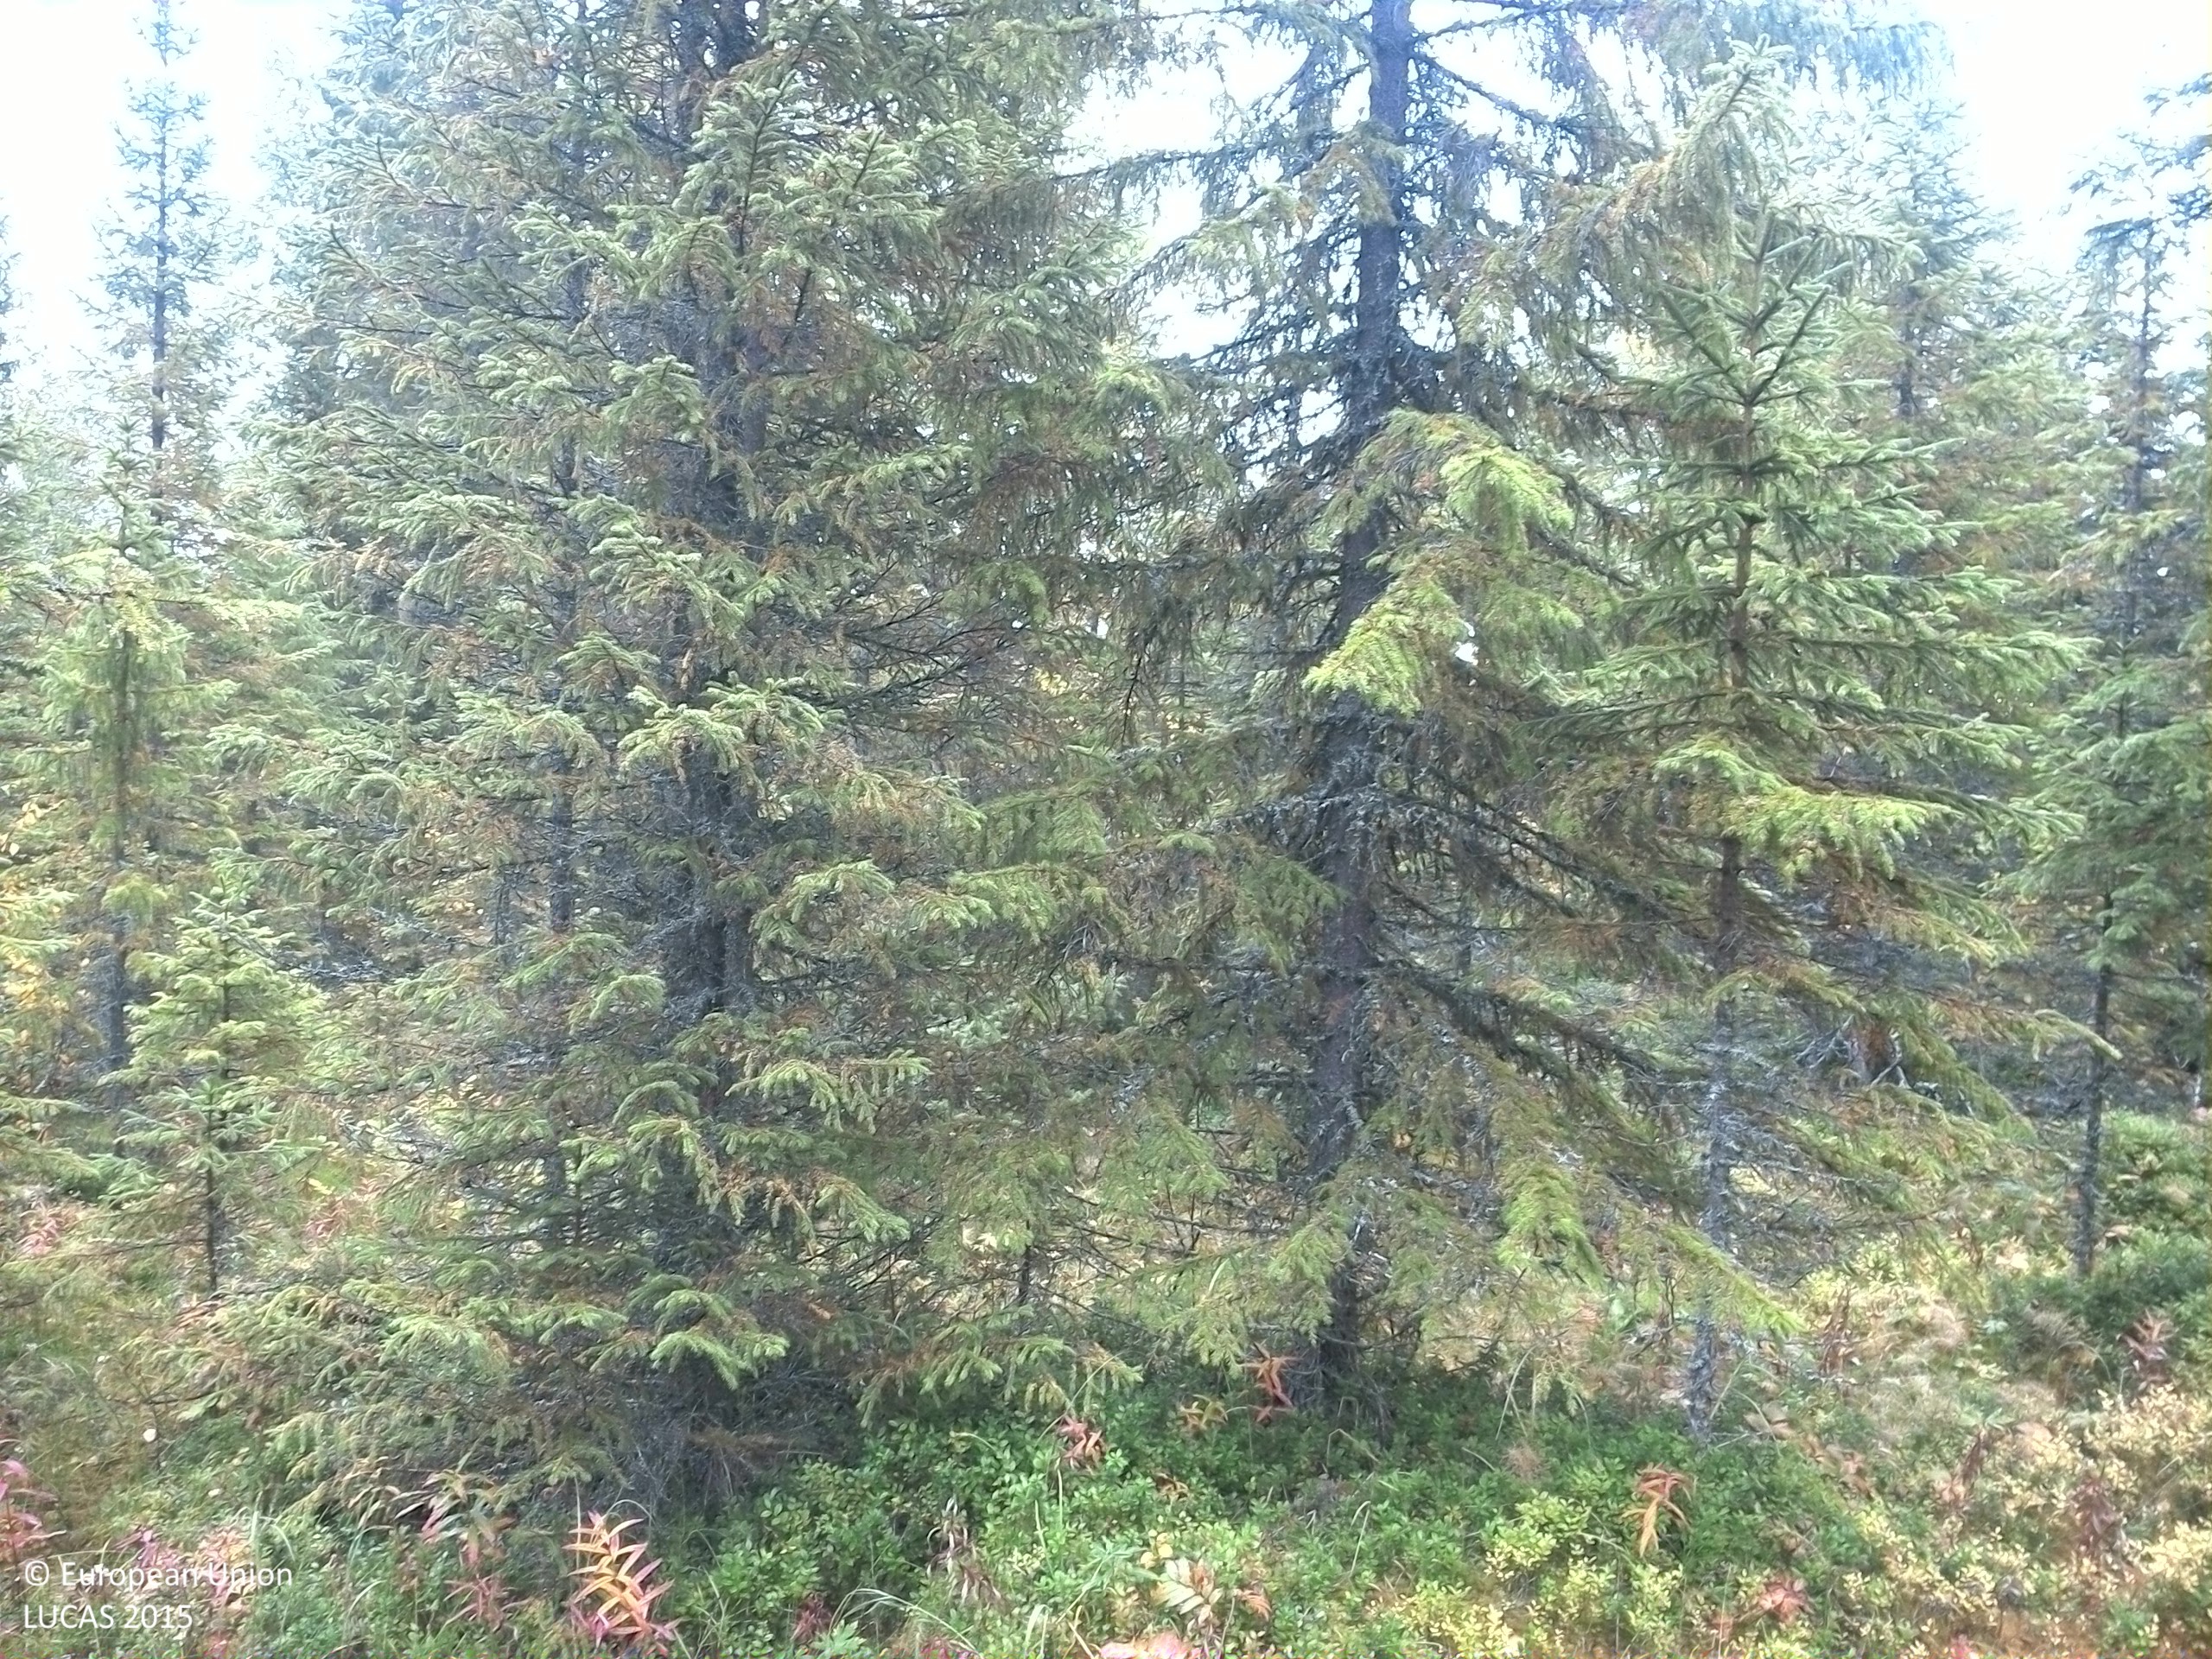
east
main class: Woodland
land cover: Spruce dominated coniferous woodland
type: boreal forest
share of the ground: 50 - 75 %
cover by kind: coniferous forest trees 60 %, shrubs 20 %, lichens and mosses 10 %, broadleaved forest trees 5 %, herbaceous plants 5 %
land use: Forestry
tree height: > 5 m
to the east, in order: Spruce dominated coniferous woodland; Ditches and canals; Spruce dominated coniferous woodland; Ditches and canals; Spruce dominated coniferous woodland
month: September
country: SE
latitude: 63.6206
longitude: 15.8442
